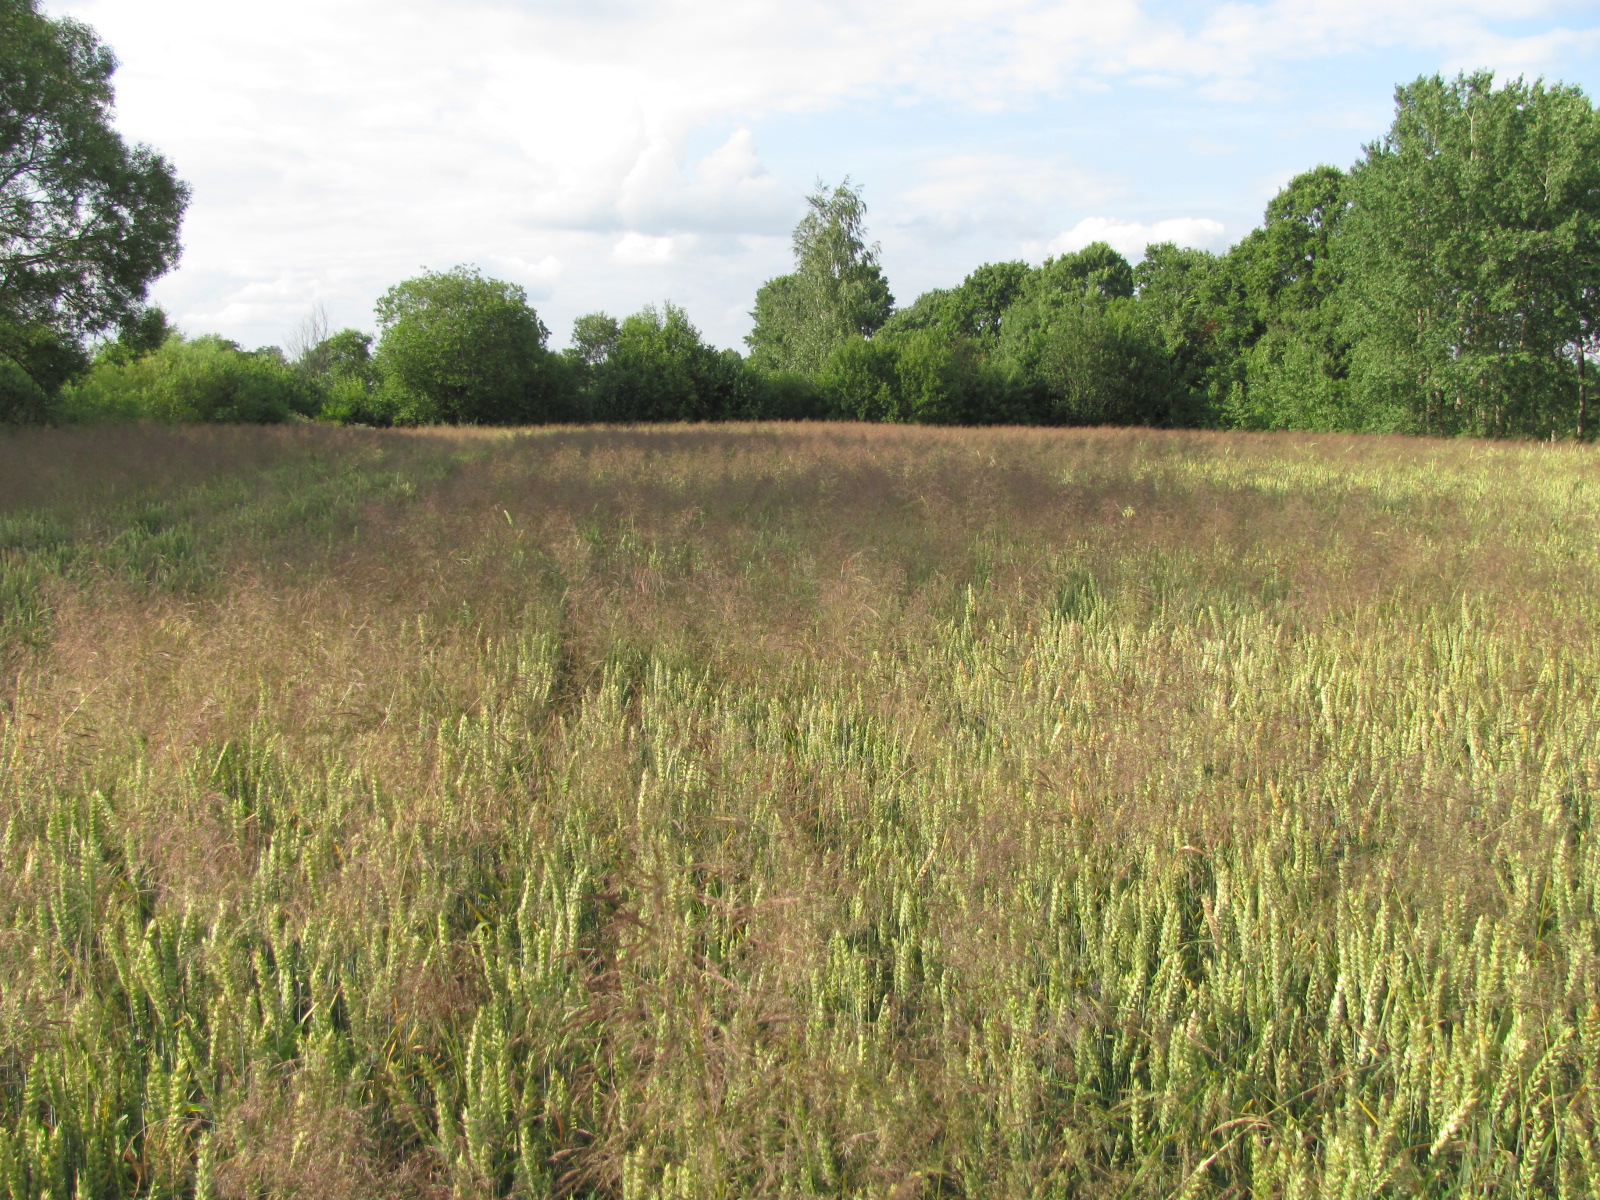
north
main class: Cropland
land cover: Common wheat
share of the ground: > 75 %
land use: Agriculture (excluding fallow land and kitchen gardens)
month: July
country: LV
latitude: 56.3561
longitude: 24.2522
